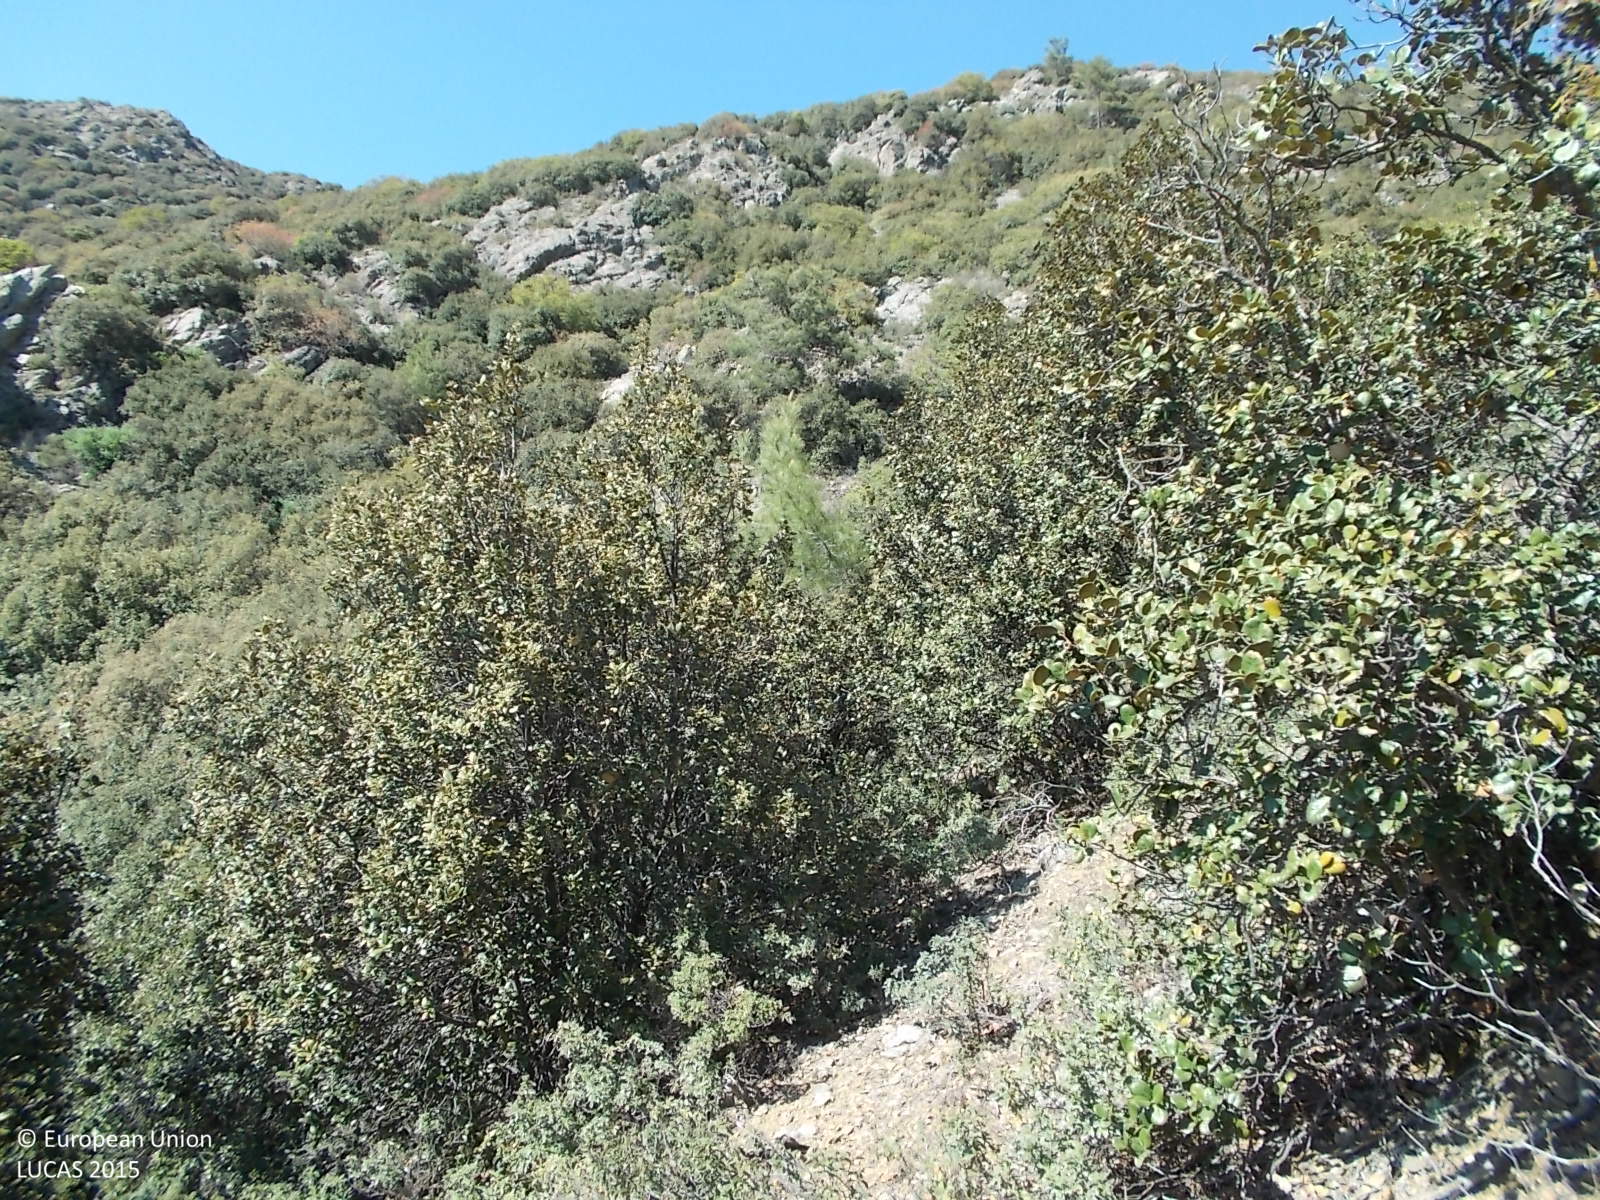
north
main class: Shrubland
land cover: Shrubland with sparse tree cover
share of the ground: > 75 %
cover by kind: shrubs 95 %, broadleaved forest trees 5 %
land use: Semi-natural and natural areas not in use
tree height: > 5 m
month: May
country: CY
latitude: 34.8929
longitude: 33.0532
